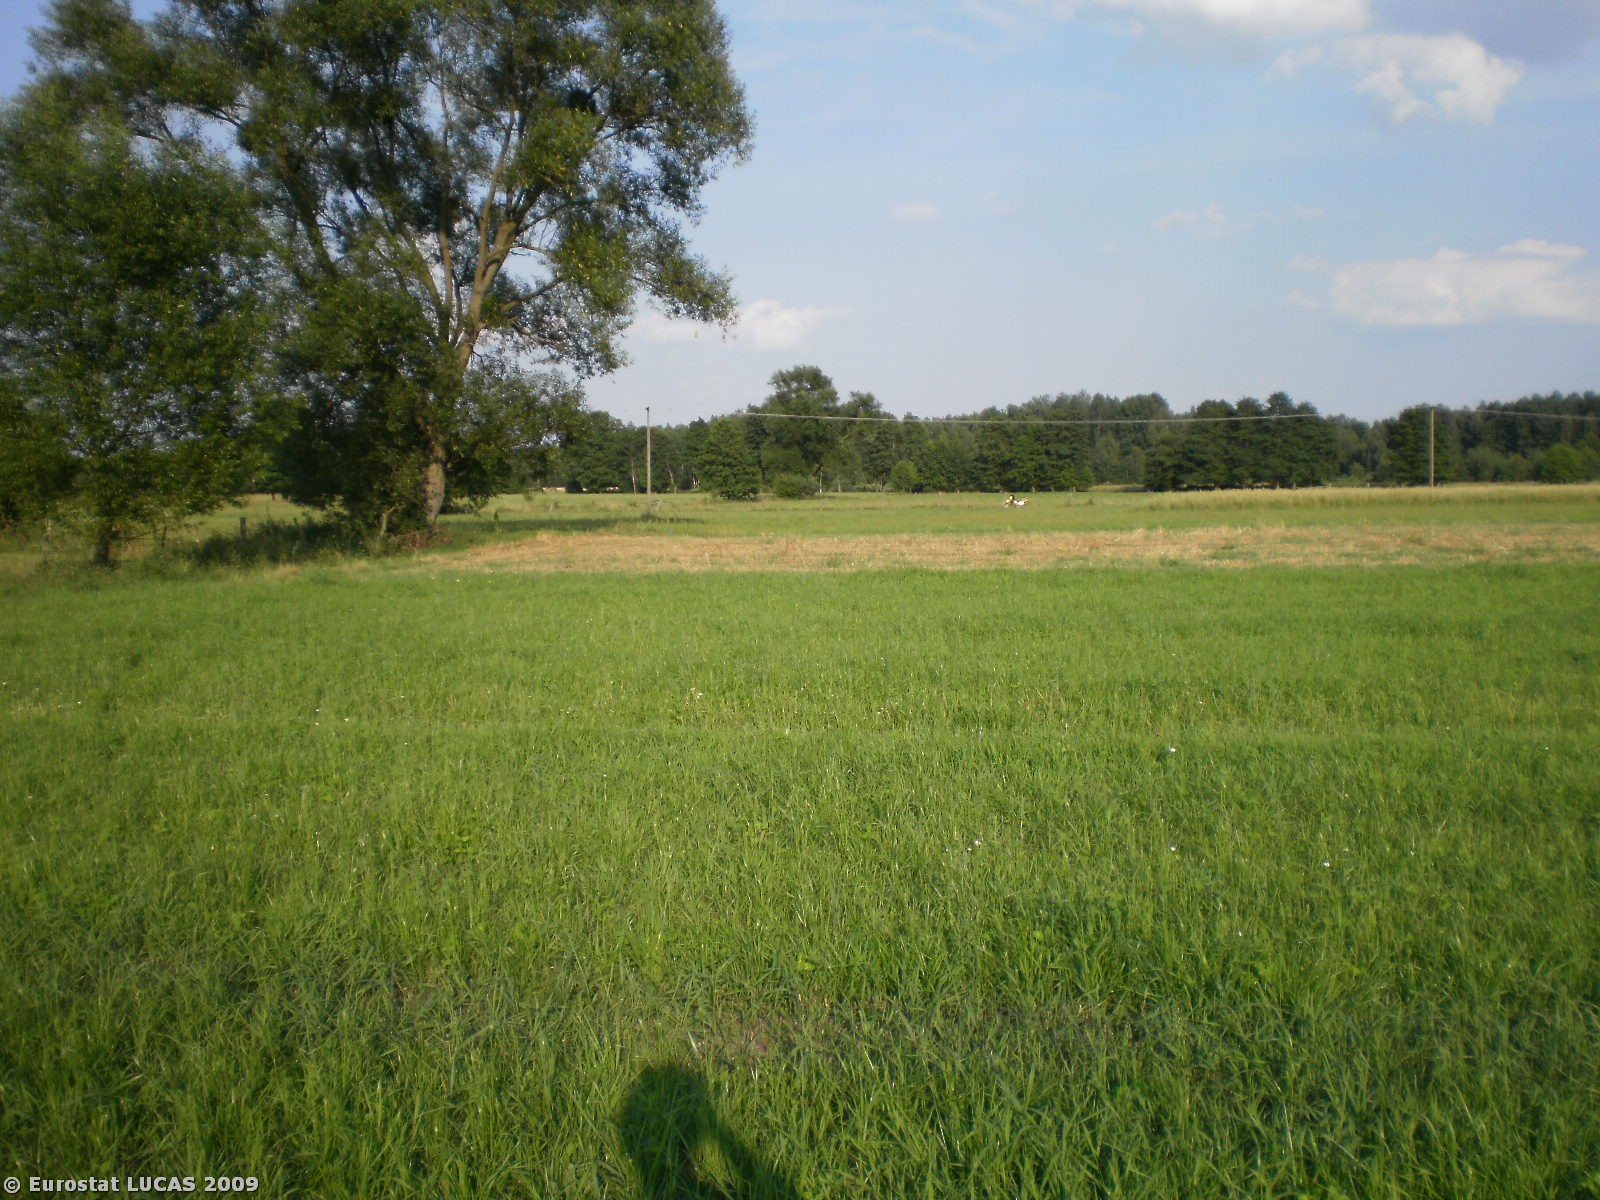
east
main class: Grassland
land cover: Grassland without tree/shrub cover
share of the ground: > 75 %
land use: Agriculture (excluding fallow land and kitchen gardens)
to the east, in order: Grassland without tree/shrub cover; Mixed cereals for fodder; Grassland without tree/shrub cover; Fences; Grassland without tree/shrub cover; Electric lines; Grassland without tree/shrub cover; Fences; Grassland without tree/shrub cover
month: July
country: PL
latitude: 53.4498
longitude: 21.3259
